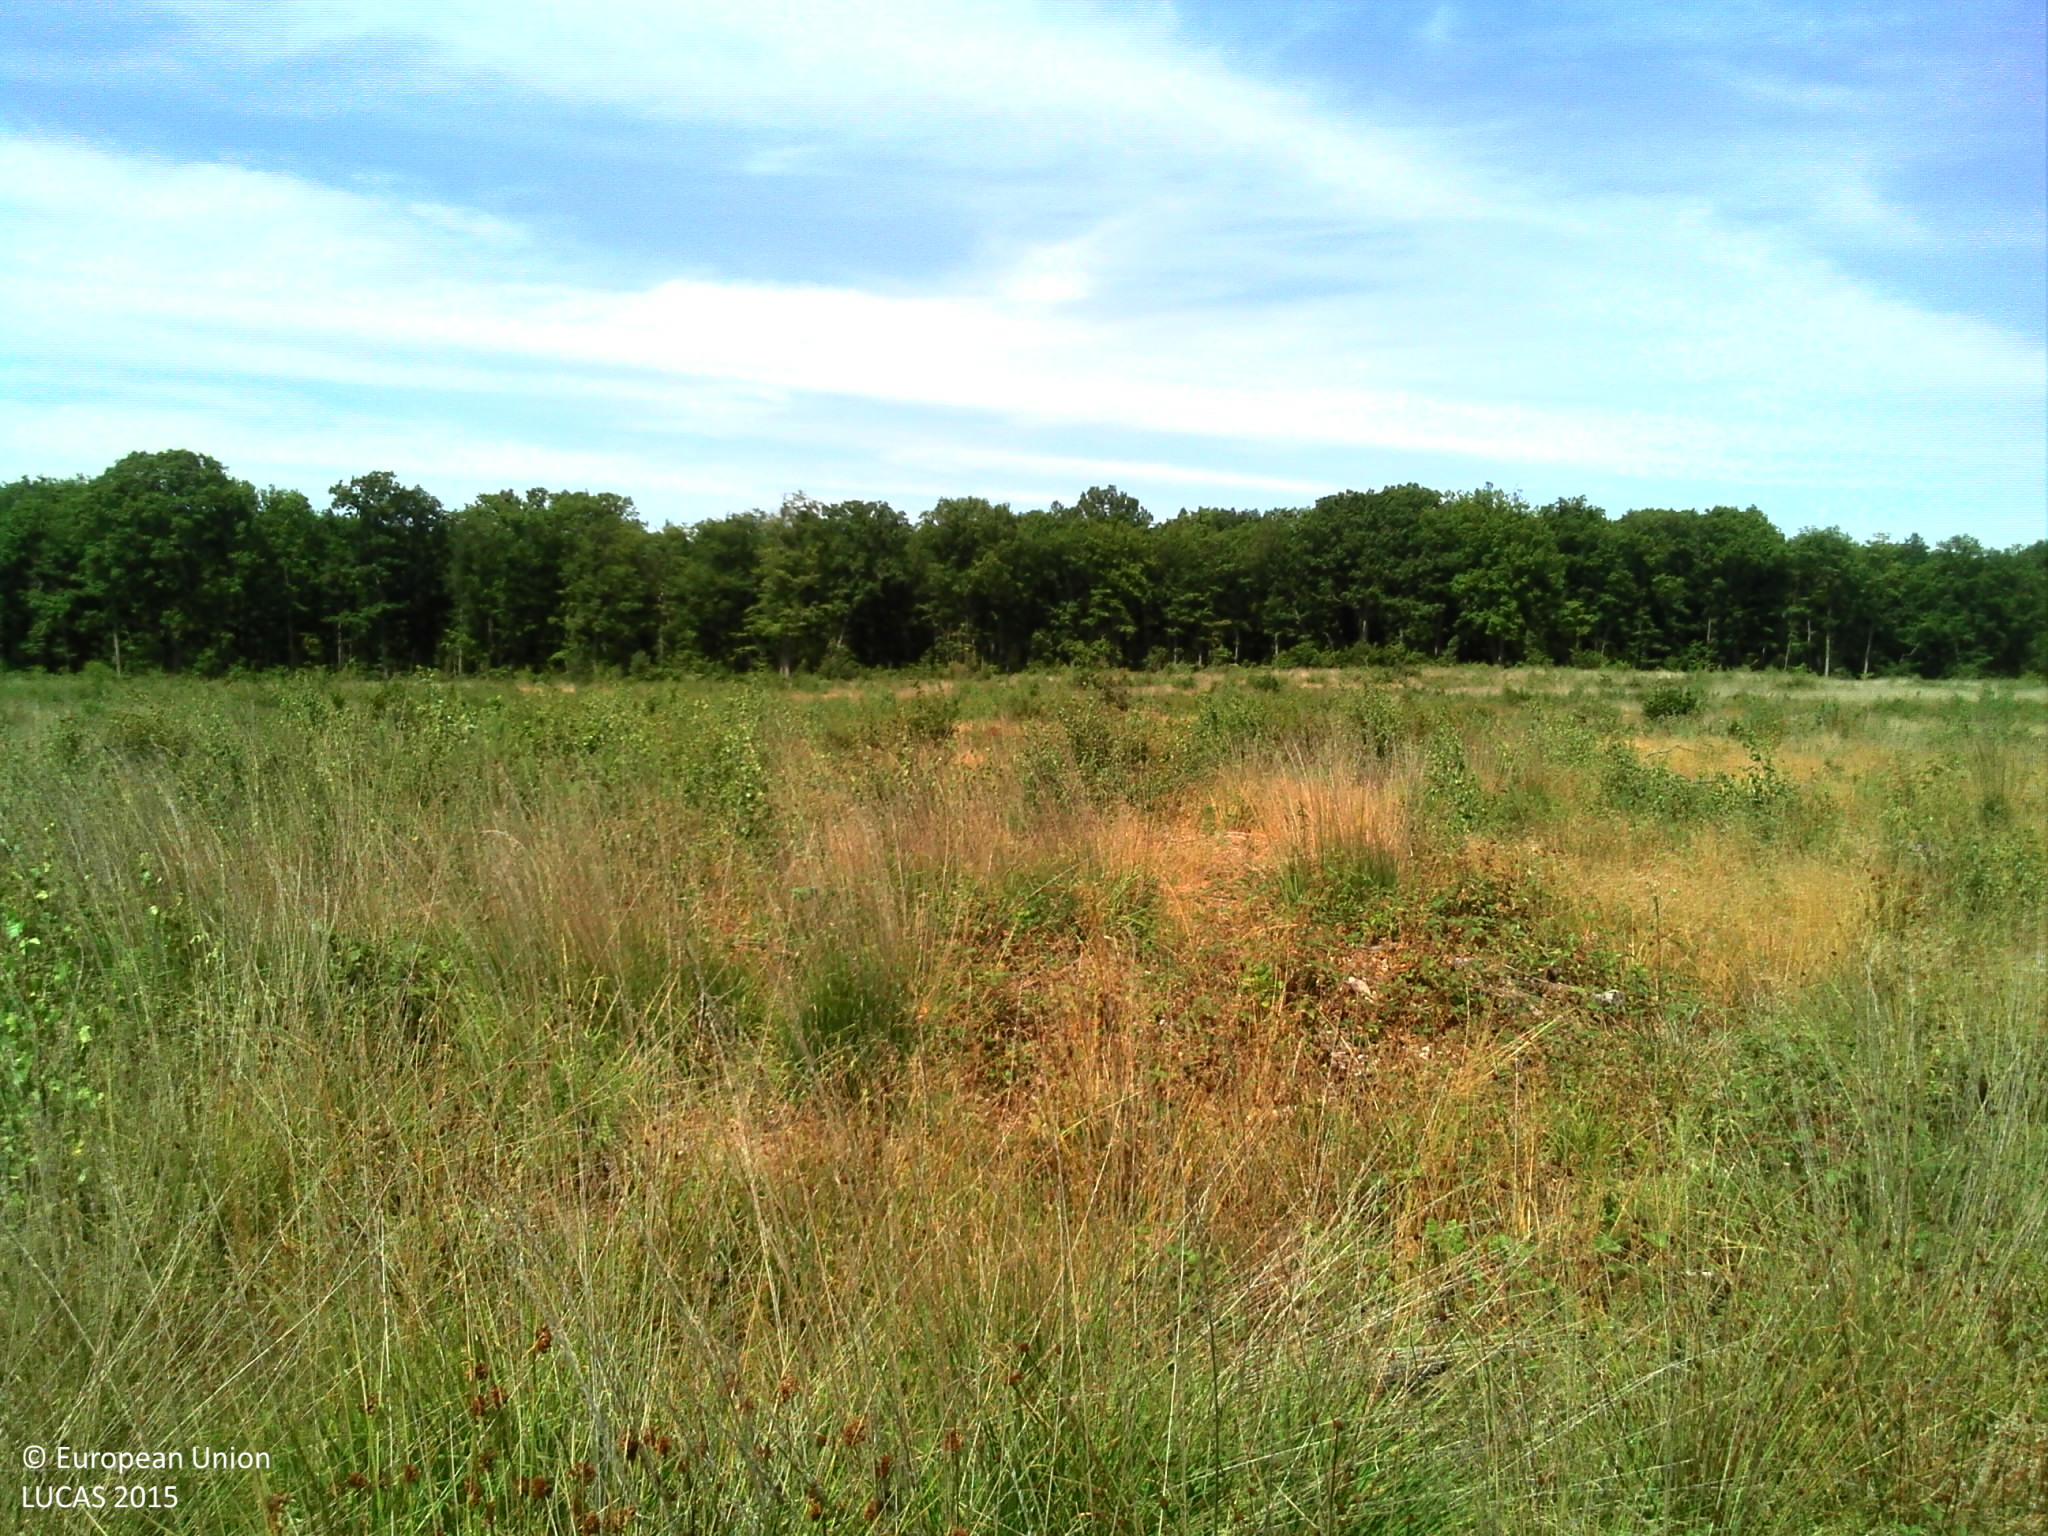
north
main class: Shrubland
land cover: Shrubland with sparse tree cover
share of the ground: > 75 %
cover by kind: herbaceous plants 85 %, shrubs 10 %, broadleaved forest trees 5 %
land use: Forestry
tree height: < 5 m
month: July
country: FR
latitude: 47.9482
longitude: 1.9675
